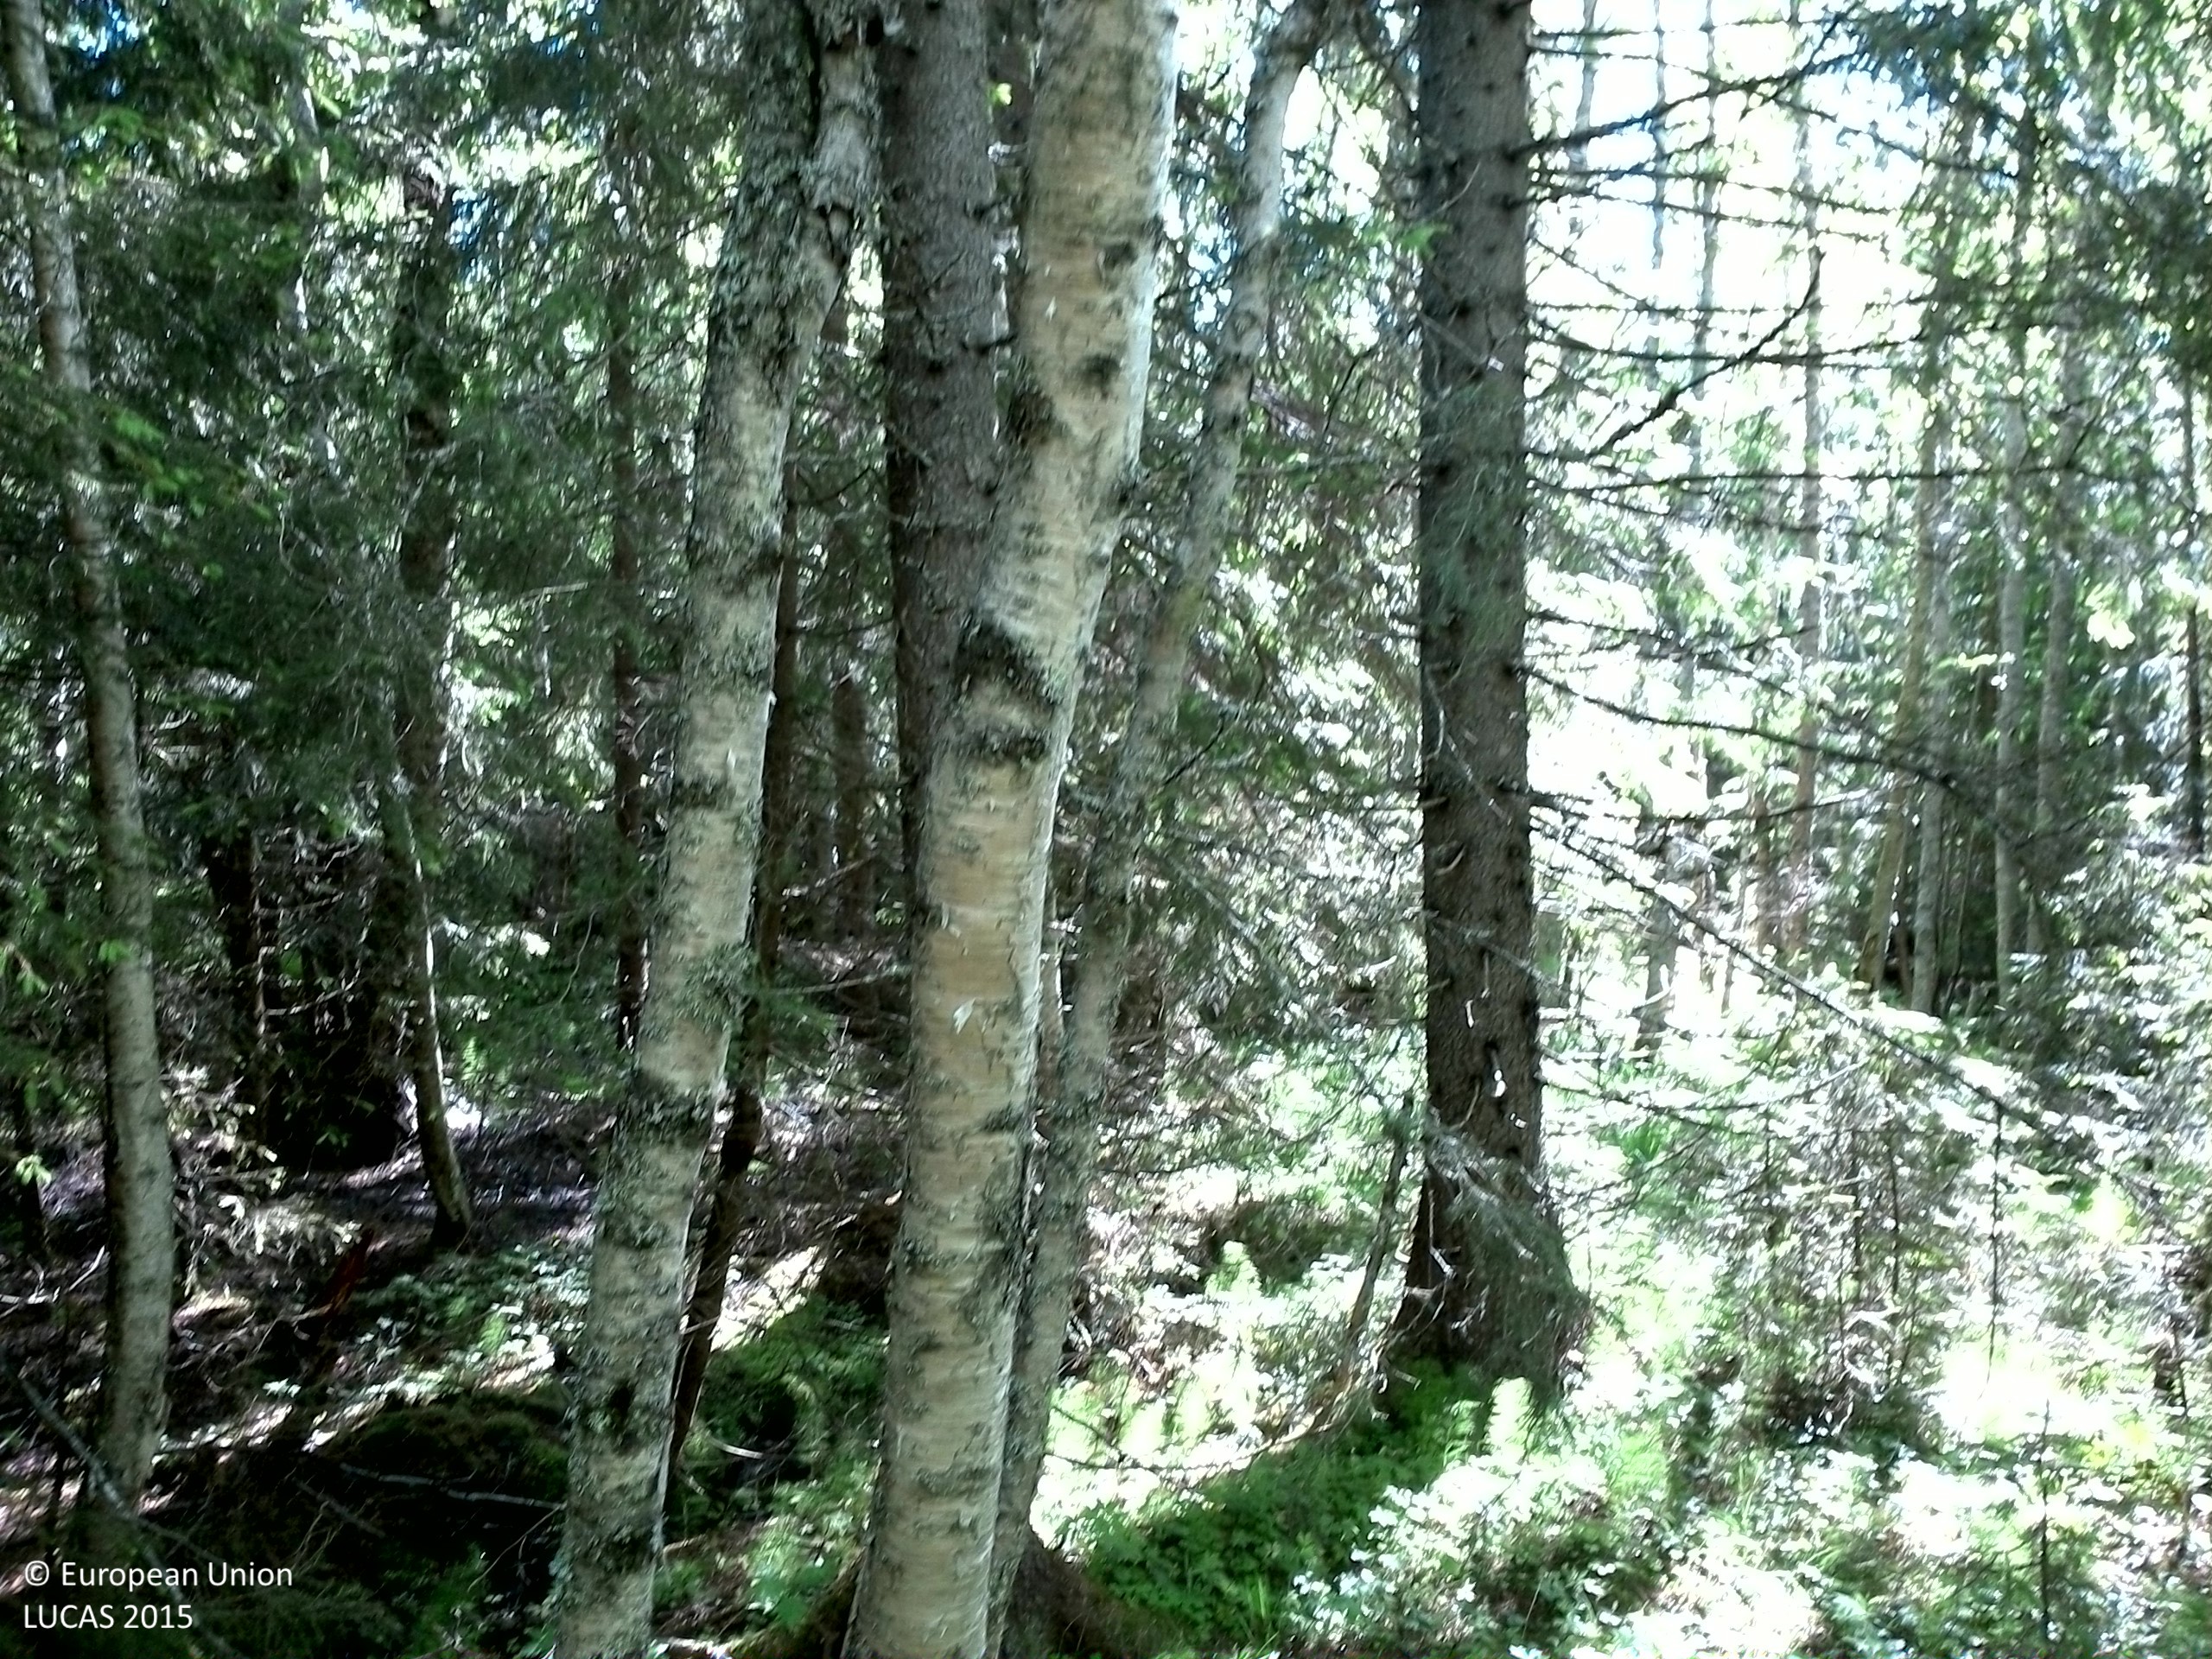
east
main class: Woodland
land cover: Spruce dominated mixed woodland
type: boreal forest
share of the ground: > 75 %
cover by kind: coniferous forest trees 60 %, broadleaved forest trees 30 %, herbaceous plants 10 %
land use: Forestry
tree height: > 5 m
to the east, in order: Spruce dominated mixed woodland; Broadleaved woodland; Fences; Broadleaved woodland; Grassland without tree/shrub cover; Paved roads, cycling and walking lanes; Grassland without tree/shrub cover; Spruce dominated coniferous woodland
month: June
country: SE
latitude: 62.7132
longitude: 17.8984
